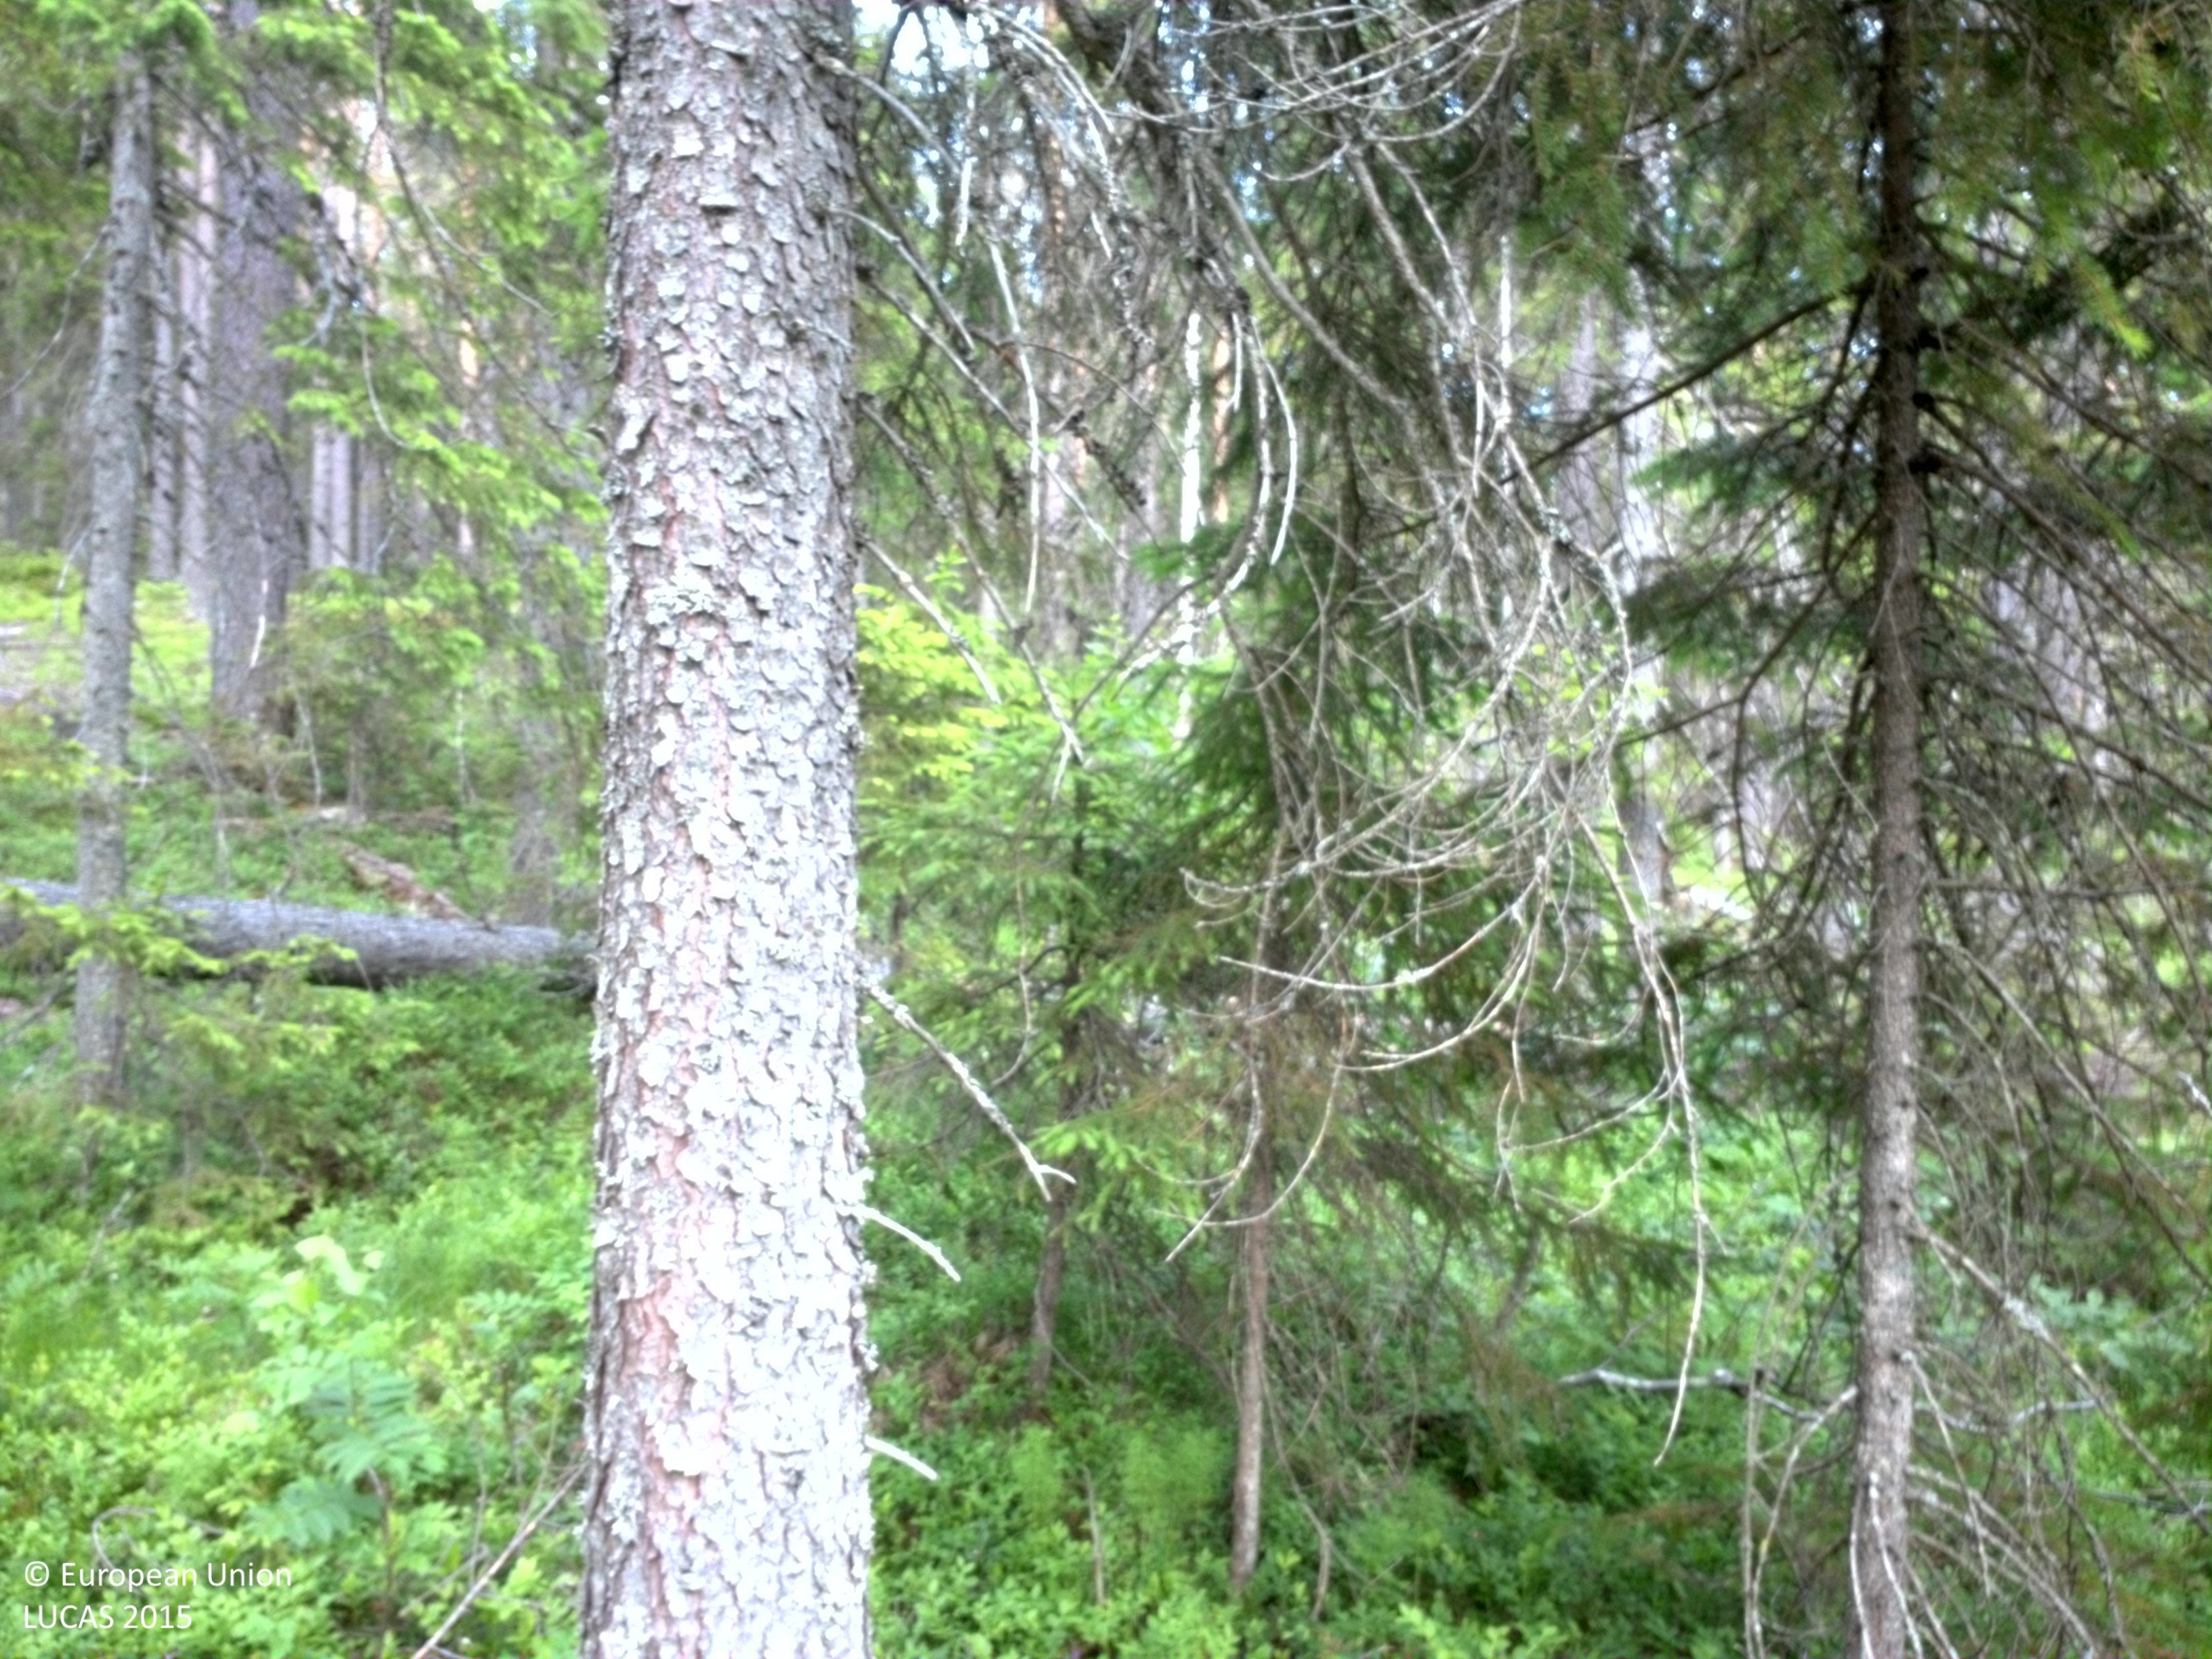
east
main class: Woodland
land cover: Other coniferous woodland
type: boreal forest
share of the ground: 25 - 50 %
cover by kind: coniferous forest trees 50 %, shrubs 30 %
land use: Forestry
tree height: > 5 m
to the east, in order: Other coniferous woodland; Shrubland with sparse tree cover; Pine dominated coniferous woodland
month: July
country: SE
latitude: 64.3266
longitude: 20.7172
